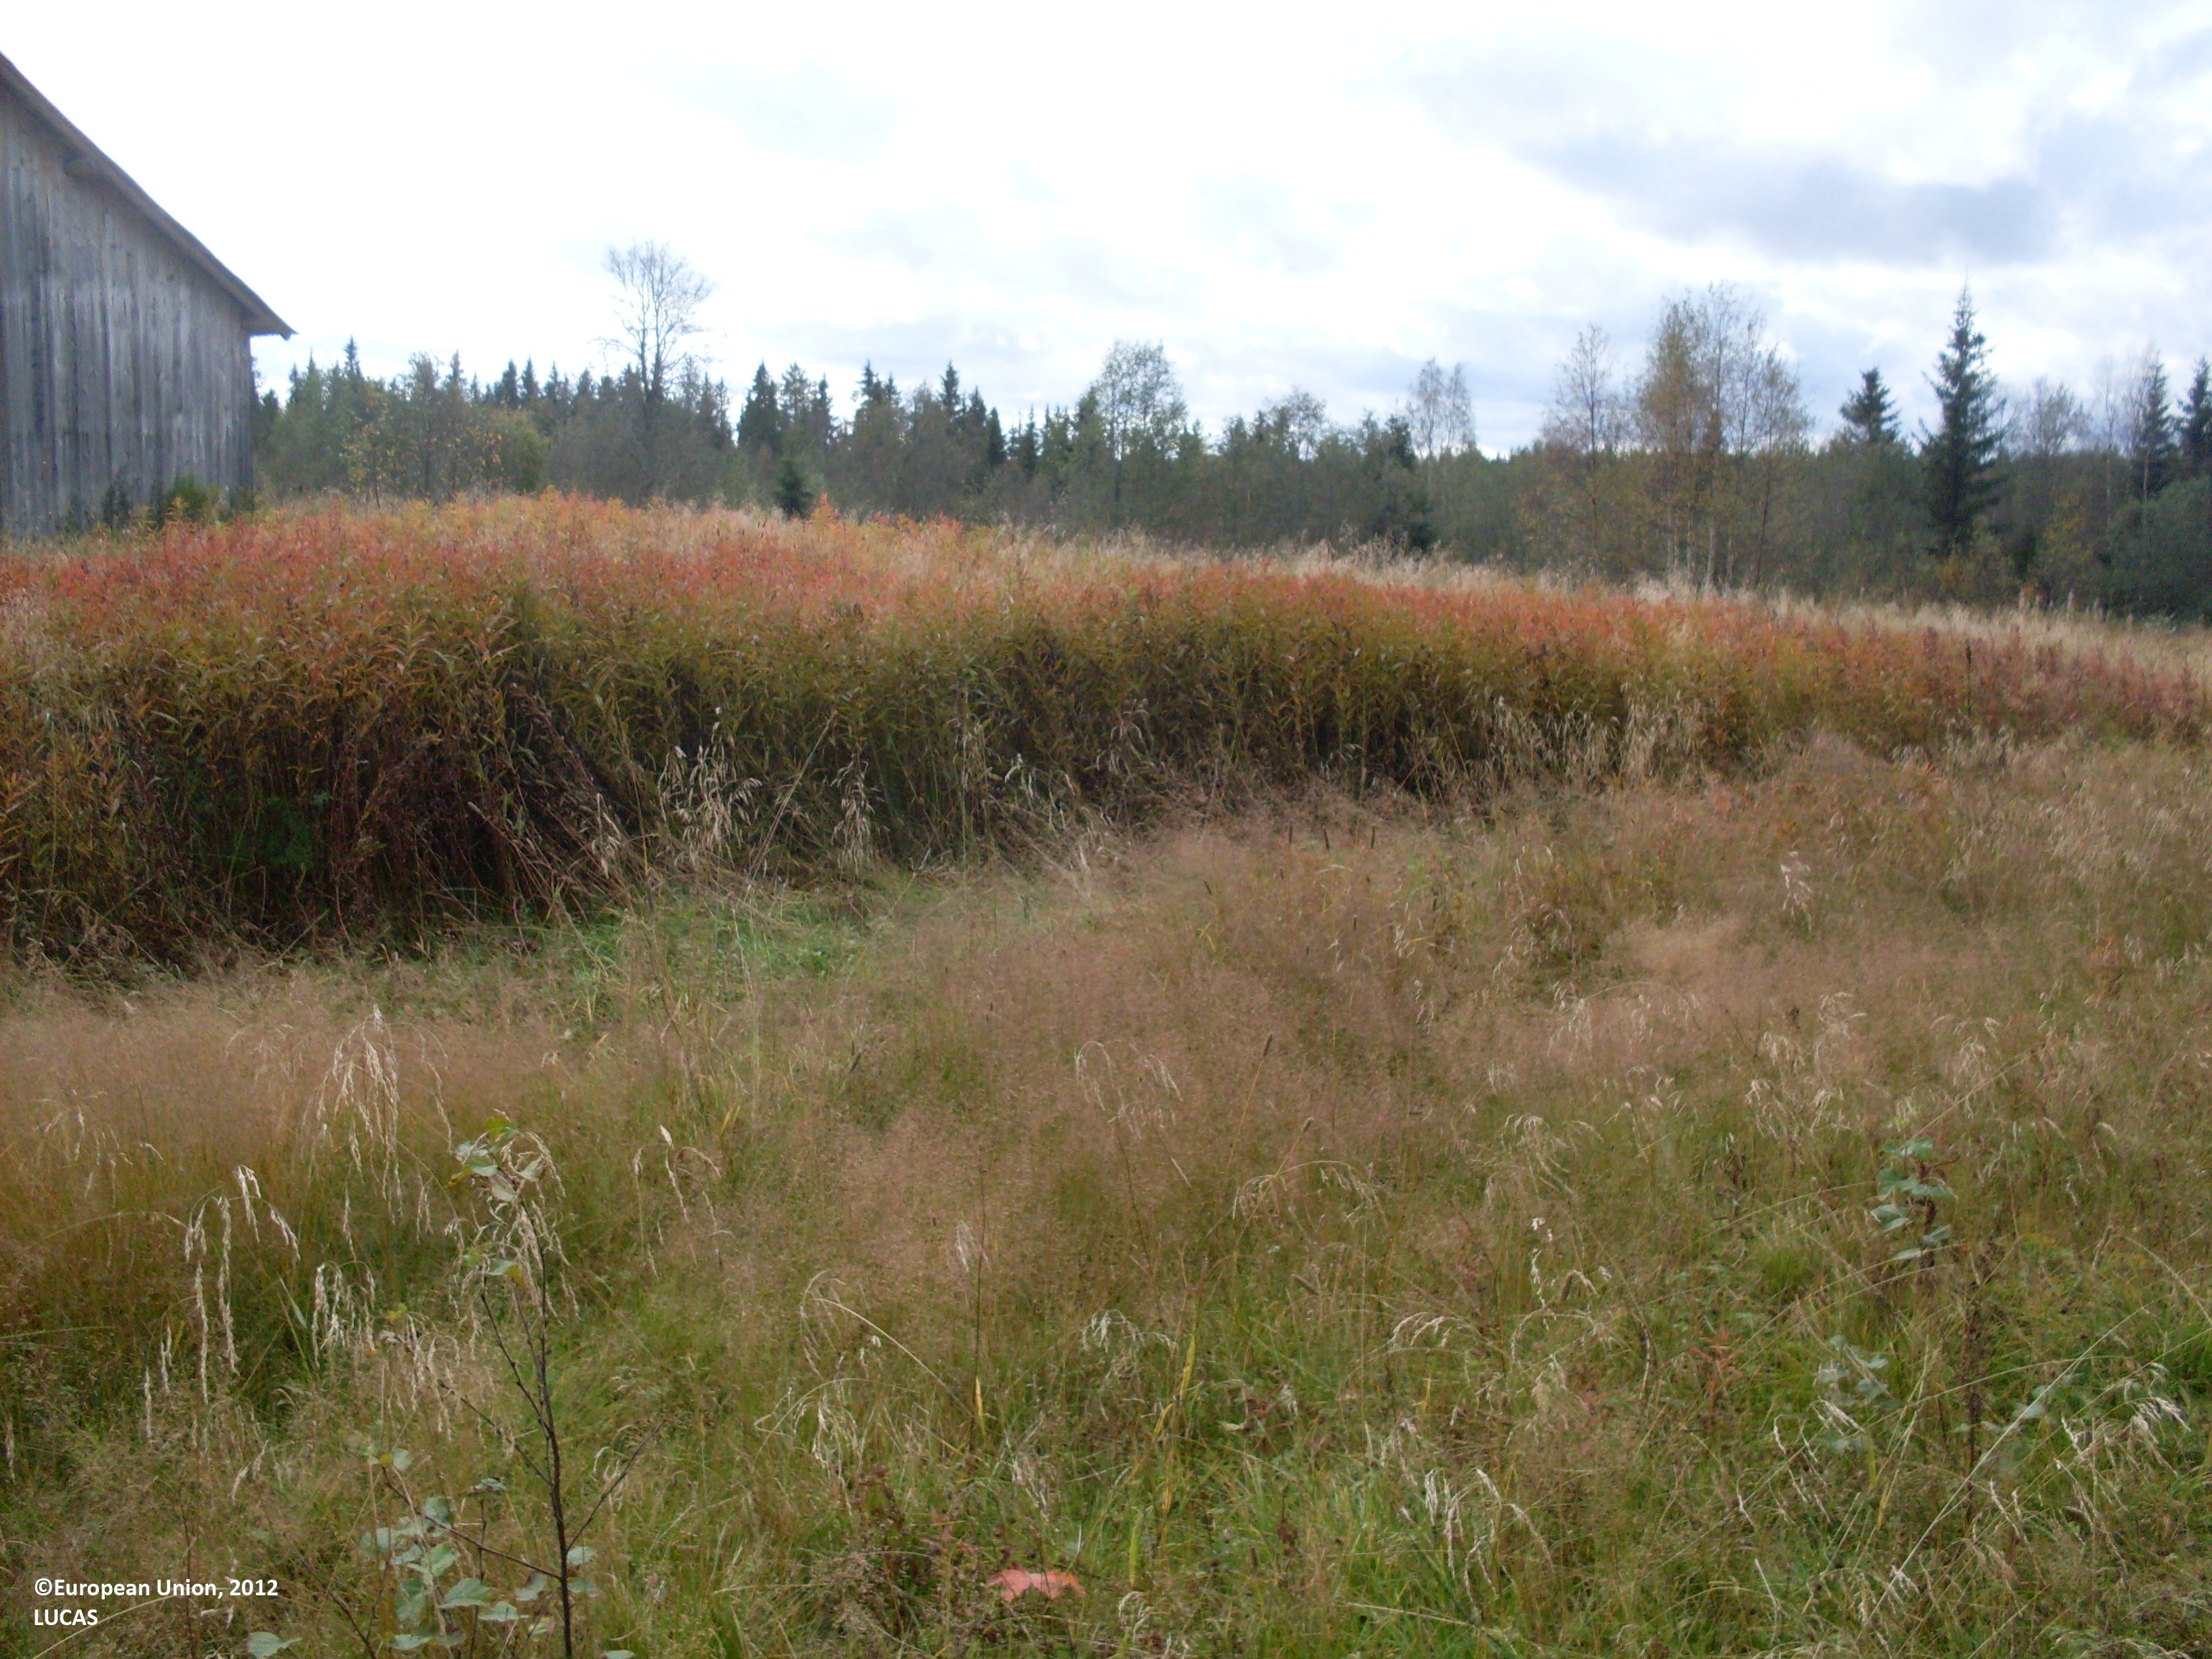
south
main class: Grassland
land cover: Grassland without tree/shrub cover
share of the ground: > 75 %
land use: Agriculture (excluding fallow land and kitchen gardens)
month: September
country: FI
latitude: 64.2554
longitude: 28.2676
